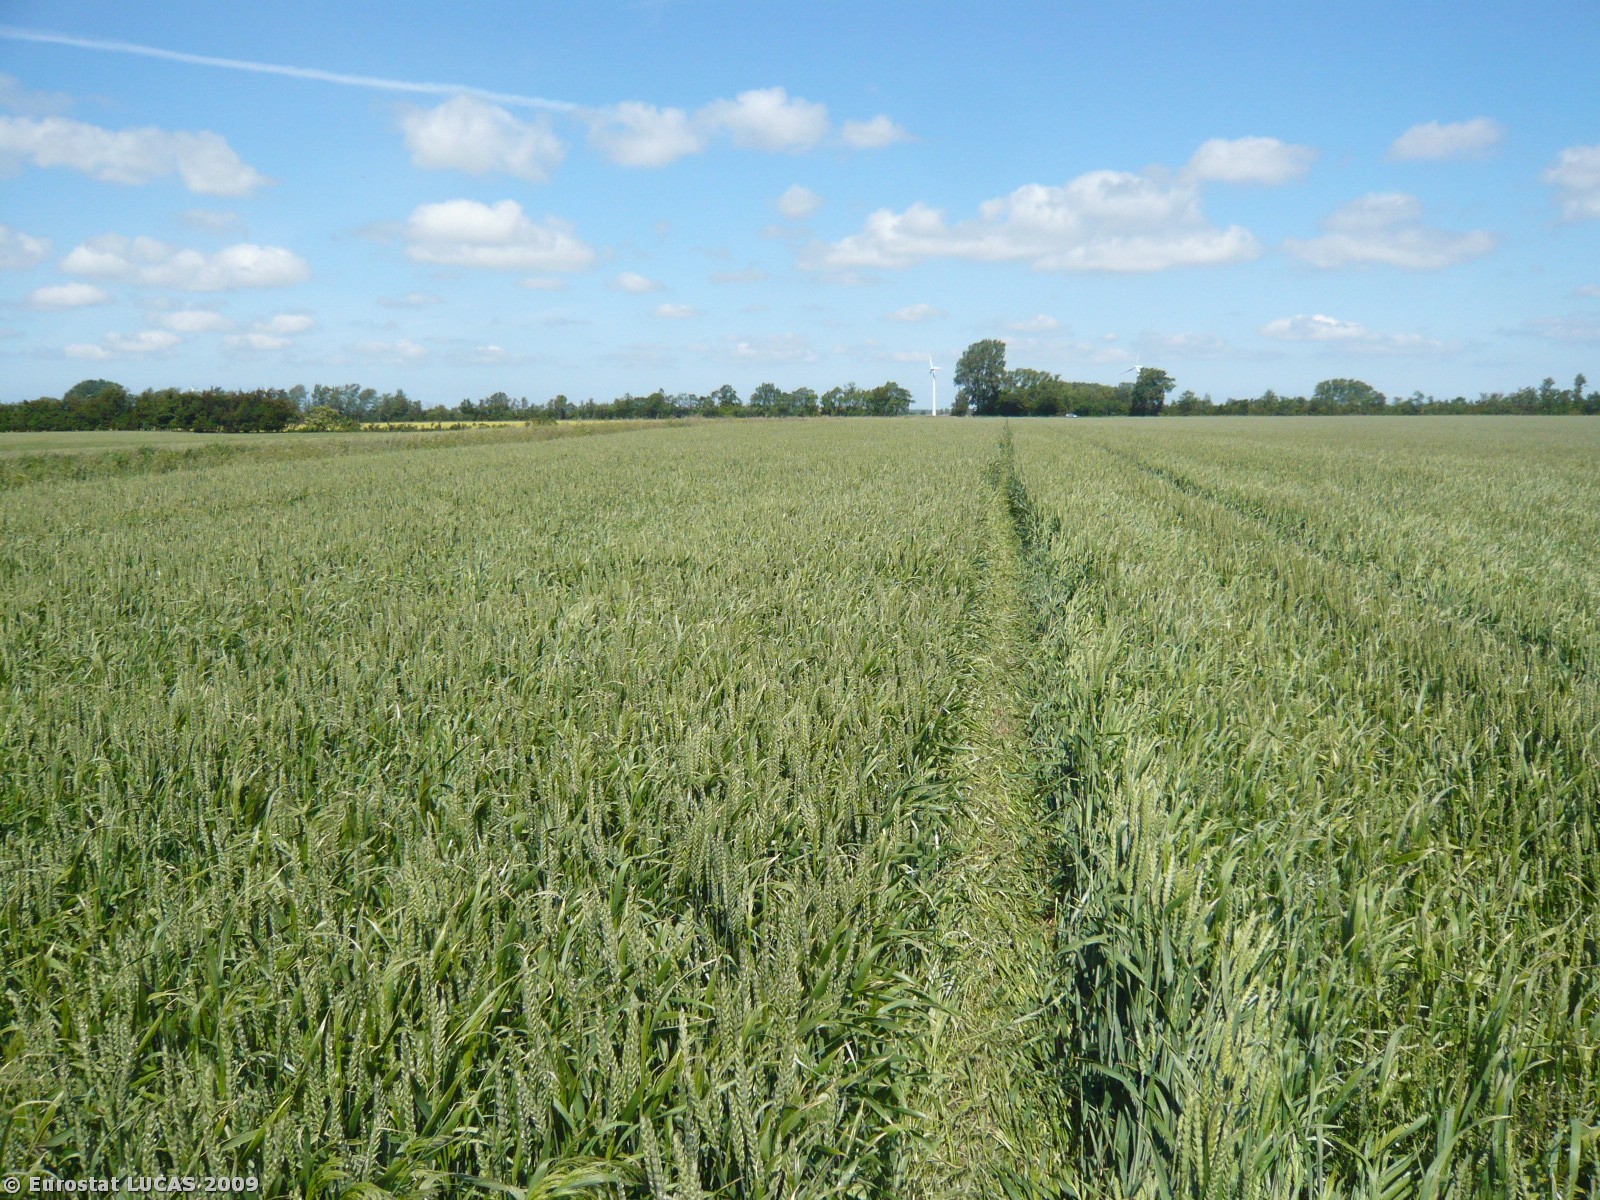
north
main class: Cropland
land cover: Common wheat
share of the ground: > 75 %
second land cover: Barley
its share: 10 - 25 %
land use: Agriculture (excluding fallow land and kitchen gardens)
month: June
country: DK
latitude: 54.7252
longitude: 11.2879
